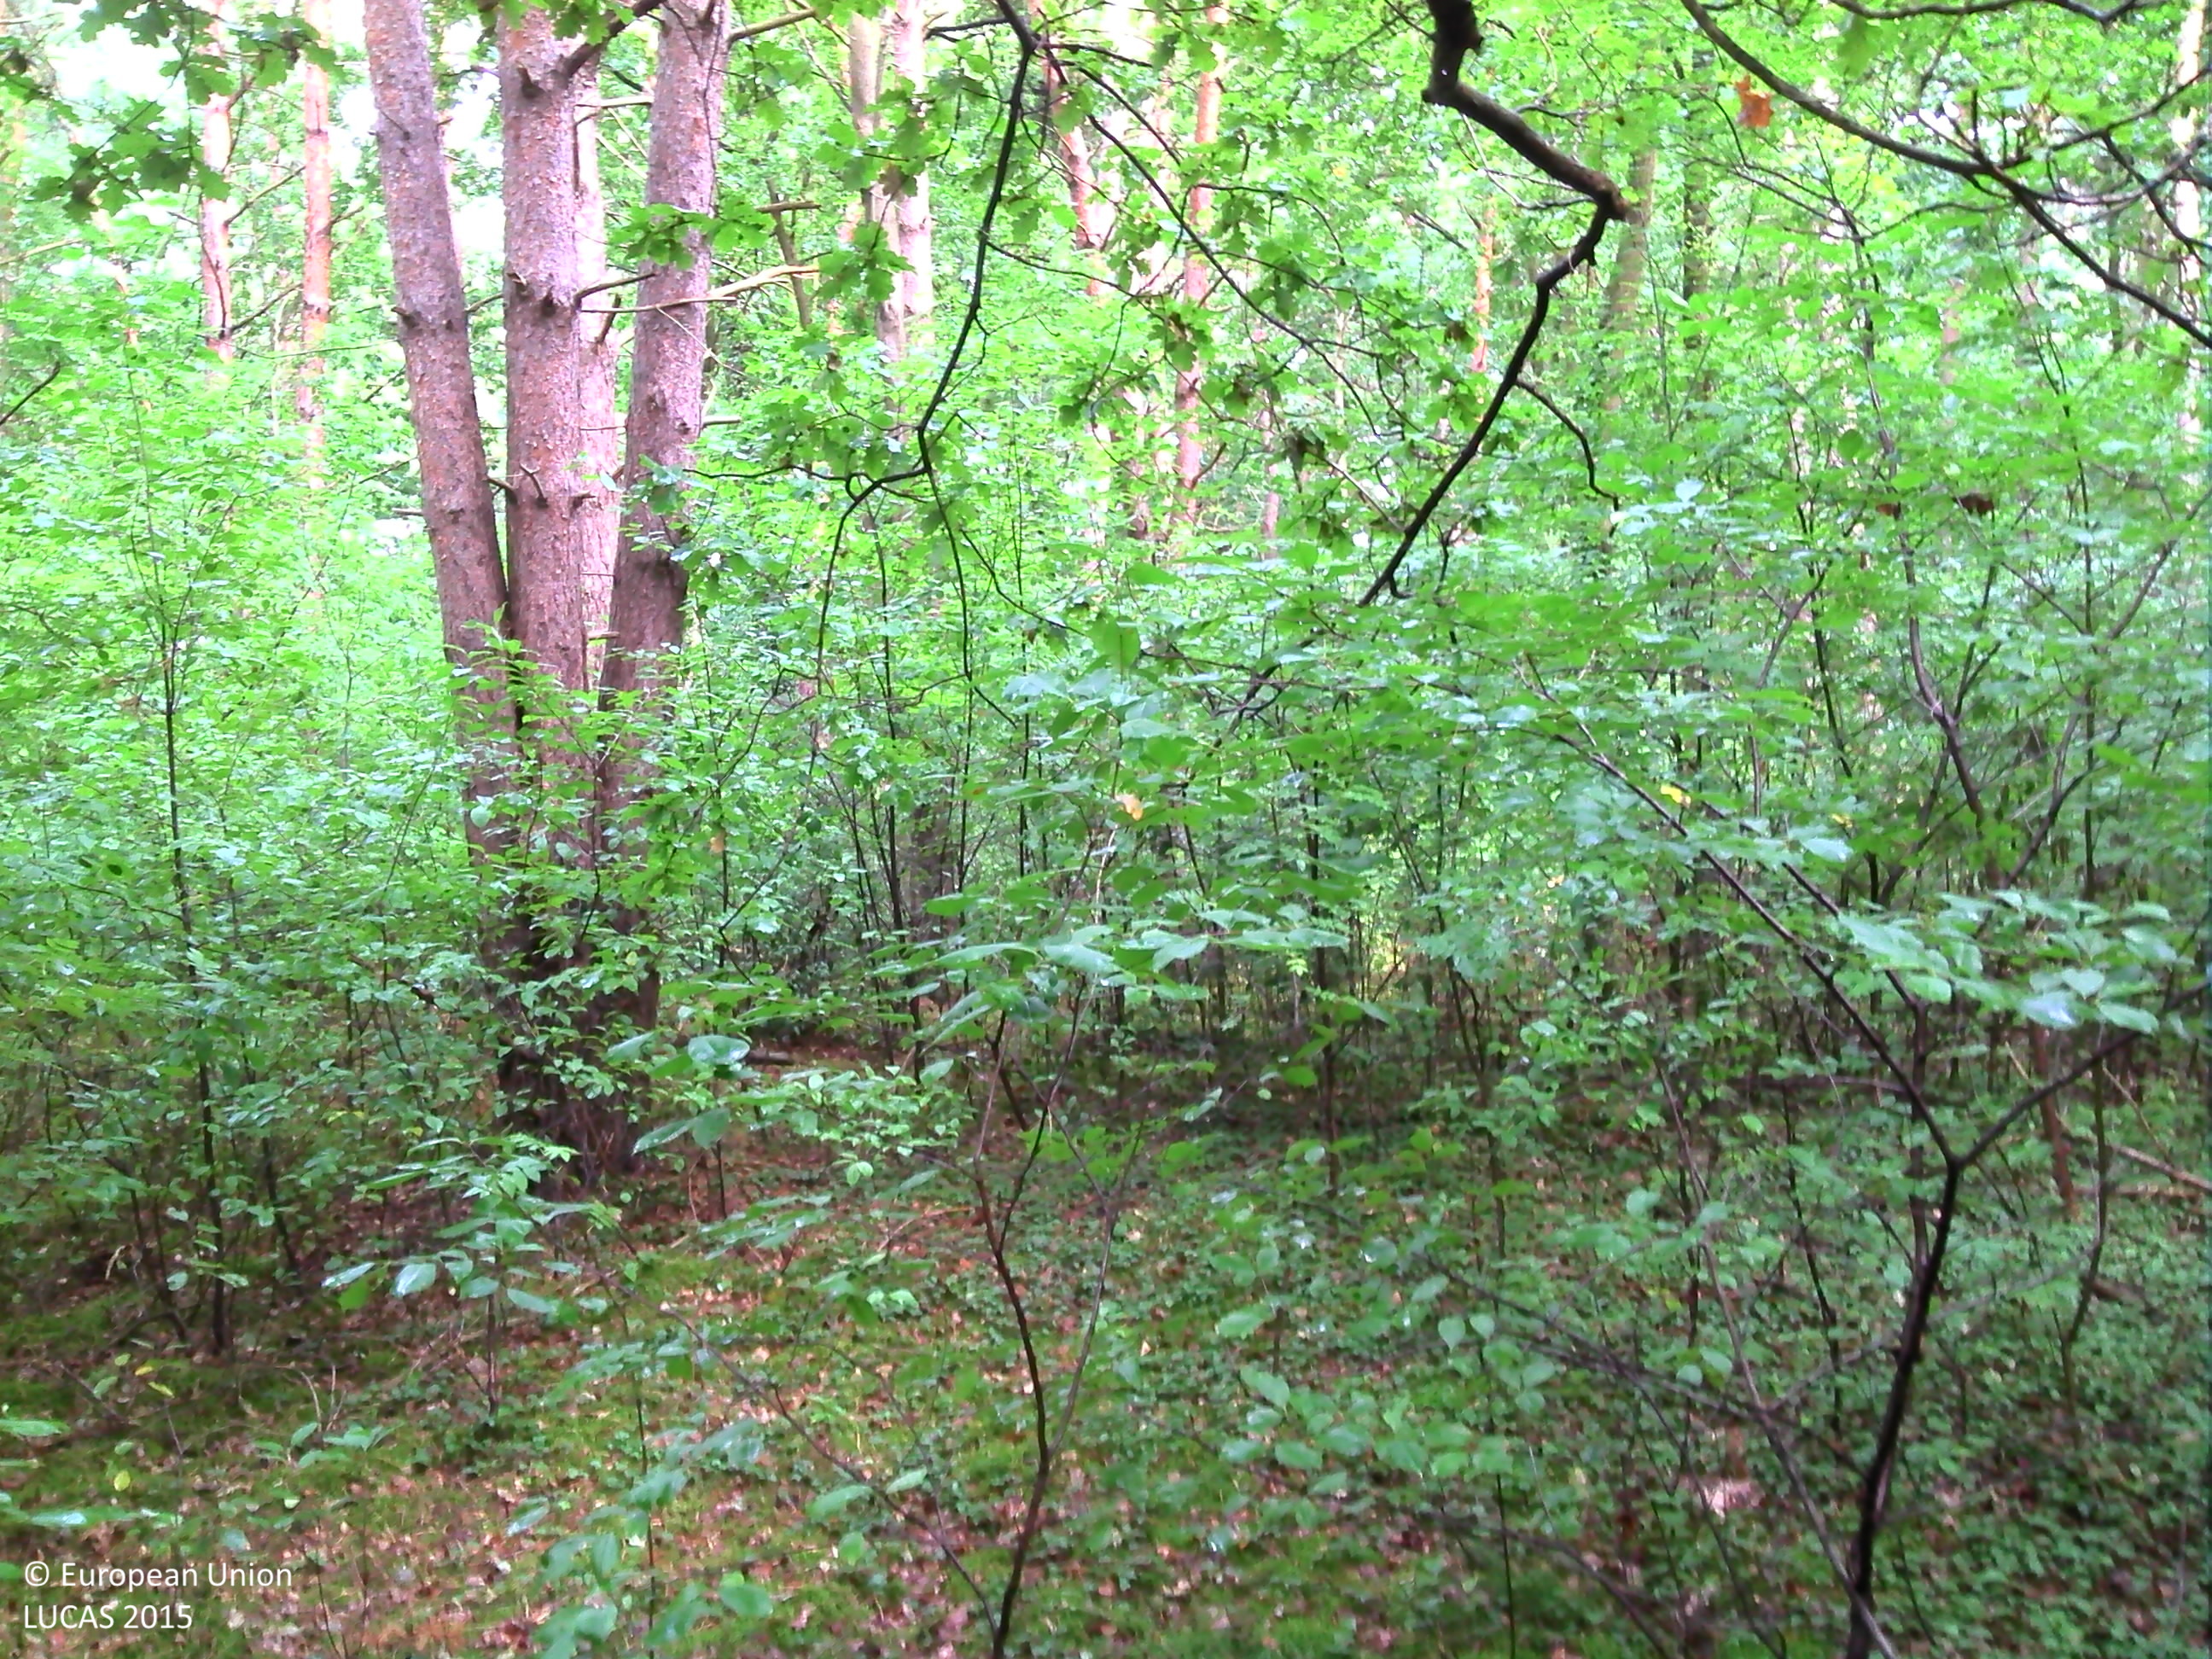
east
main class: Woodland
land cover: Pine dominated mixed woodland
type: hemiboreal forest and nemoral coniferous forest and mixed broadleaved-coniferous forest
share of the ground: > 75 %
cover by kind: coniferous forest trees 60 %, broadleaved forest trees 40 %
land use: Forestry
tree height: > 5 m
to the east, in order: Pine dominated mixed woodland; Artificial constructions in urban areas
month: August
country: BE
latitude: 50.9425
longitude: 5.5151
